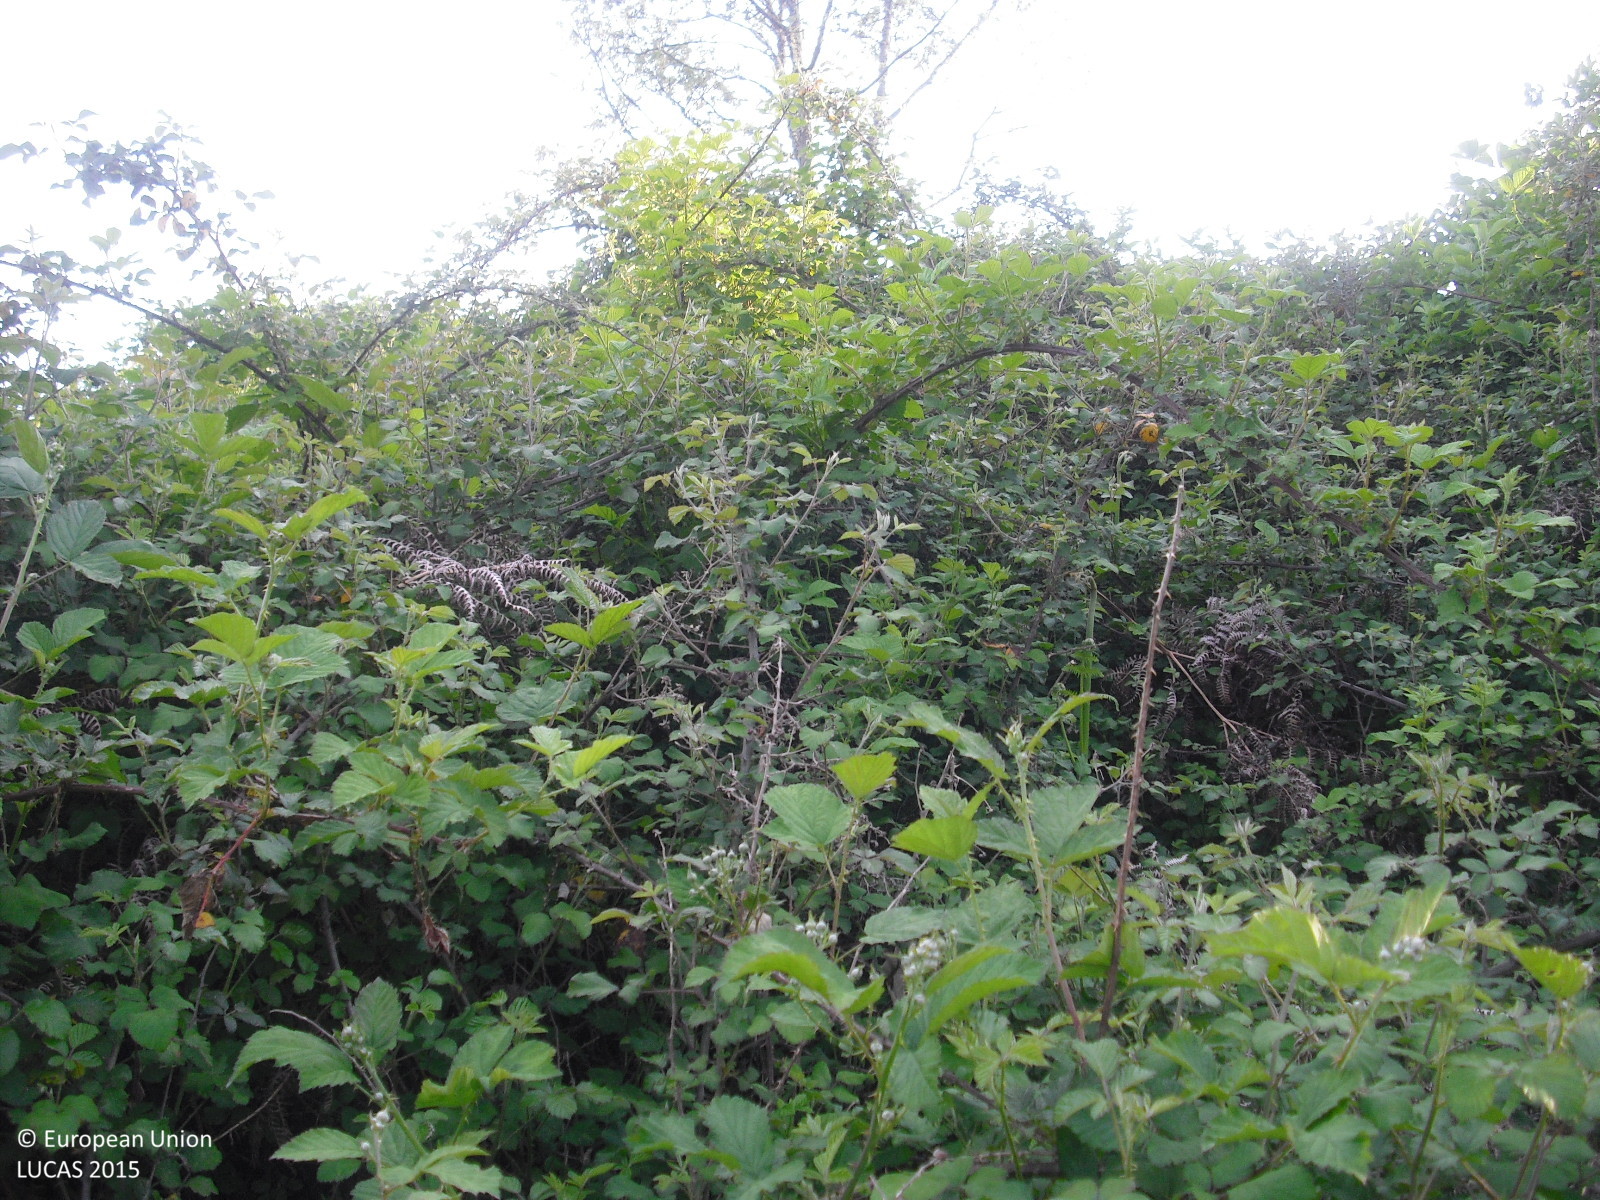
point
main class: Woodland
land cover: Broadleaved woodland
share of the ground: 10 - 25 %
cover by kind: shrubs 40 %, herbaceous plants 35 %, broadleaved forest trees 25 %
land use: Abandoned areas
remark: Burnt area
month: May
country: ES
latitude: 41.9806
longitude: -7.3038
